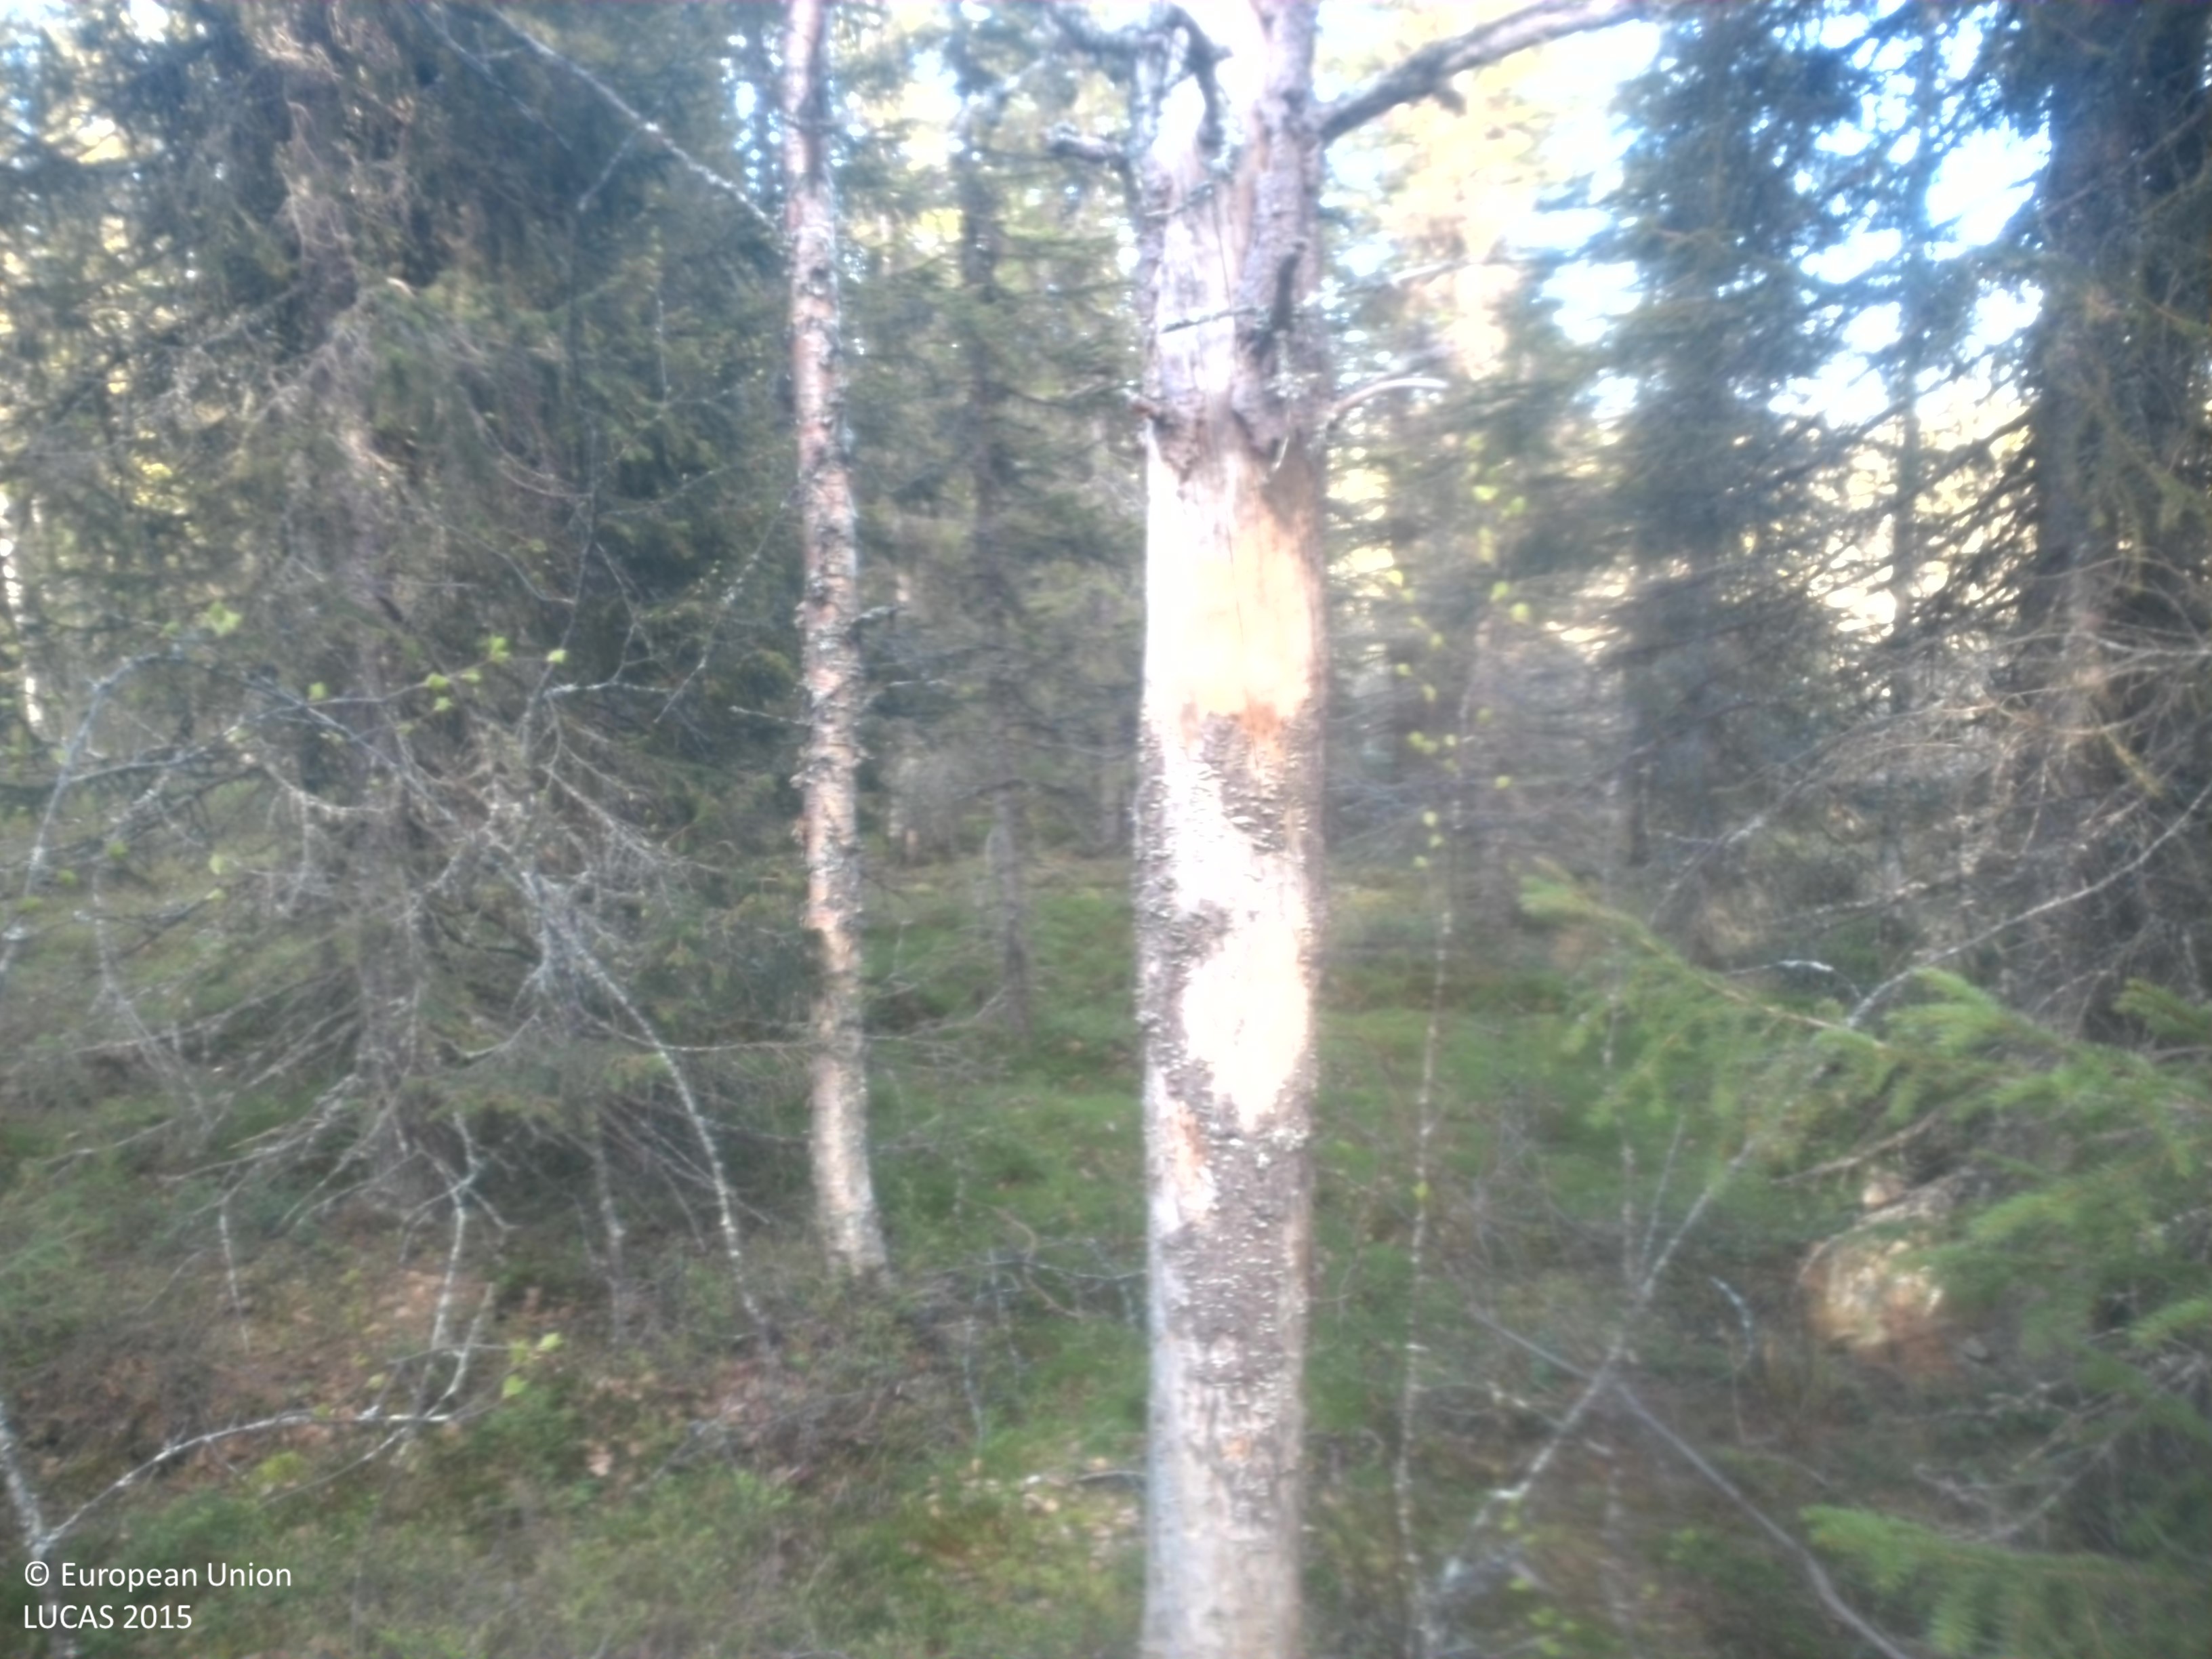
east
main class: Woodland
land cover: Spruce dominated mixed woodland
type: boreal forest
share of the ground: 25 - 50 %
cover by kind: coniferous forest trees 35 %, herbaceous plants 20 %, lichens and mosses 20 %, broadleaved forest trees 15 %, shrubs 5 %
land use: Forestry
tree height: > 5 m
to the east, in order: Spruce dominated mixed woodland; Rivers and streams; Shrubland with sparse tree cover; Grassland with sparse tree/shrub cover; Broadleaved woodland; Shrubland with sparse tree cover; Rivers and streams; Shrubland with sparse tree cover; Grassland without tree/shrub cover; Shrubland with sparse tree cover
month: June
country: SE
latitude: 64.4622
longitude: 17.7638
